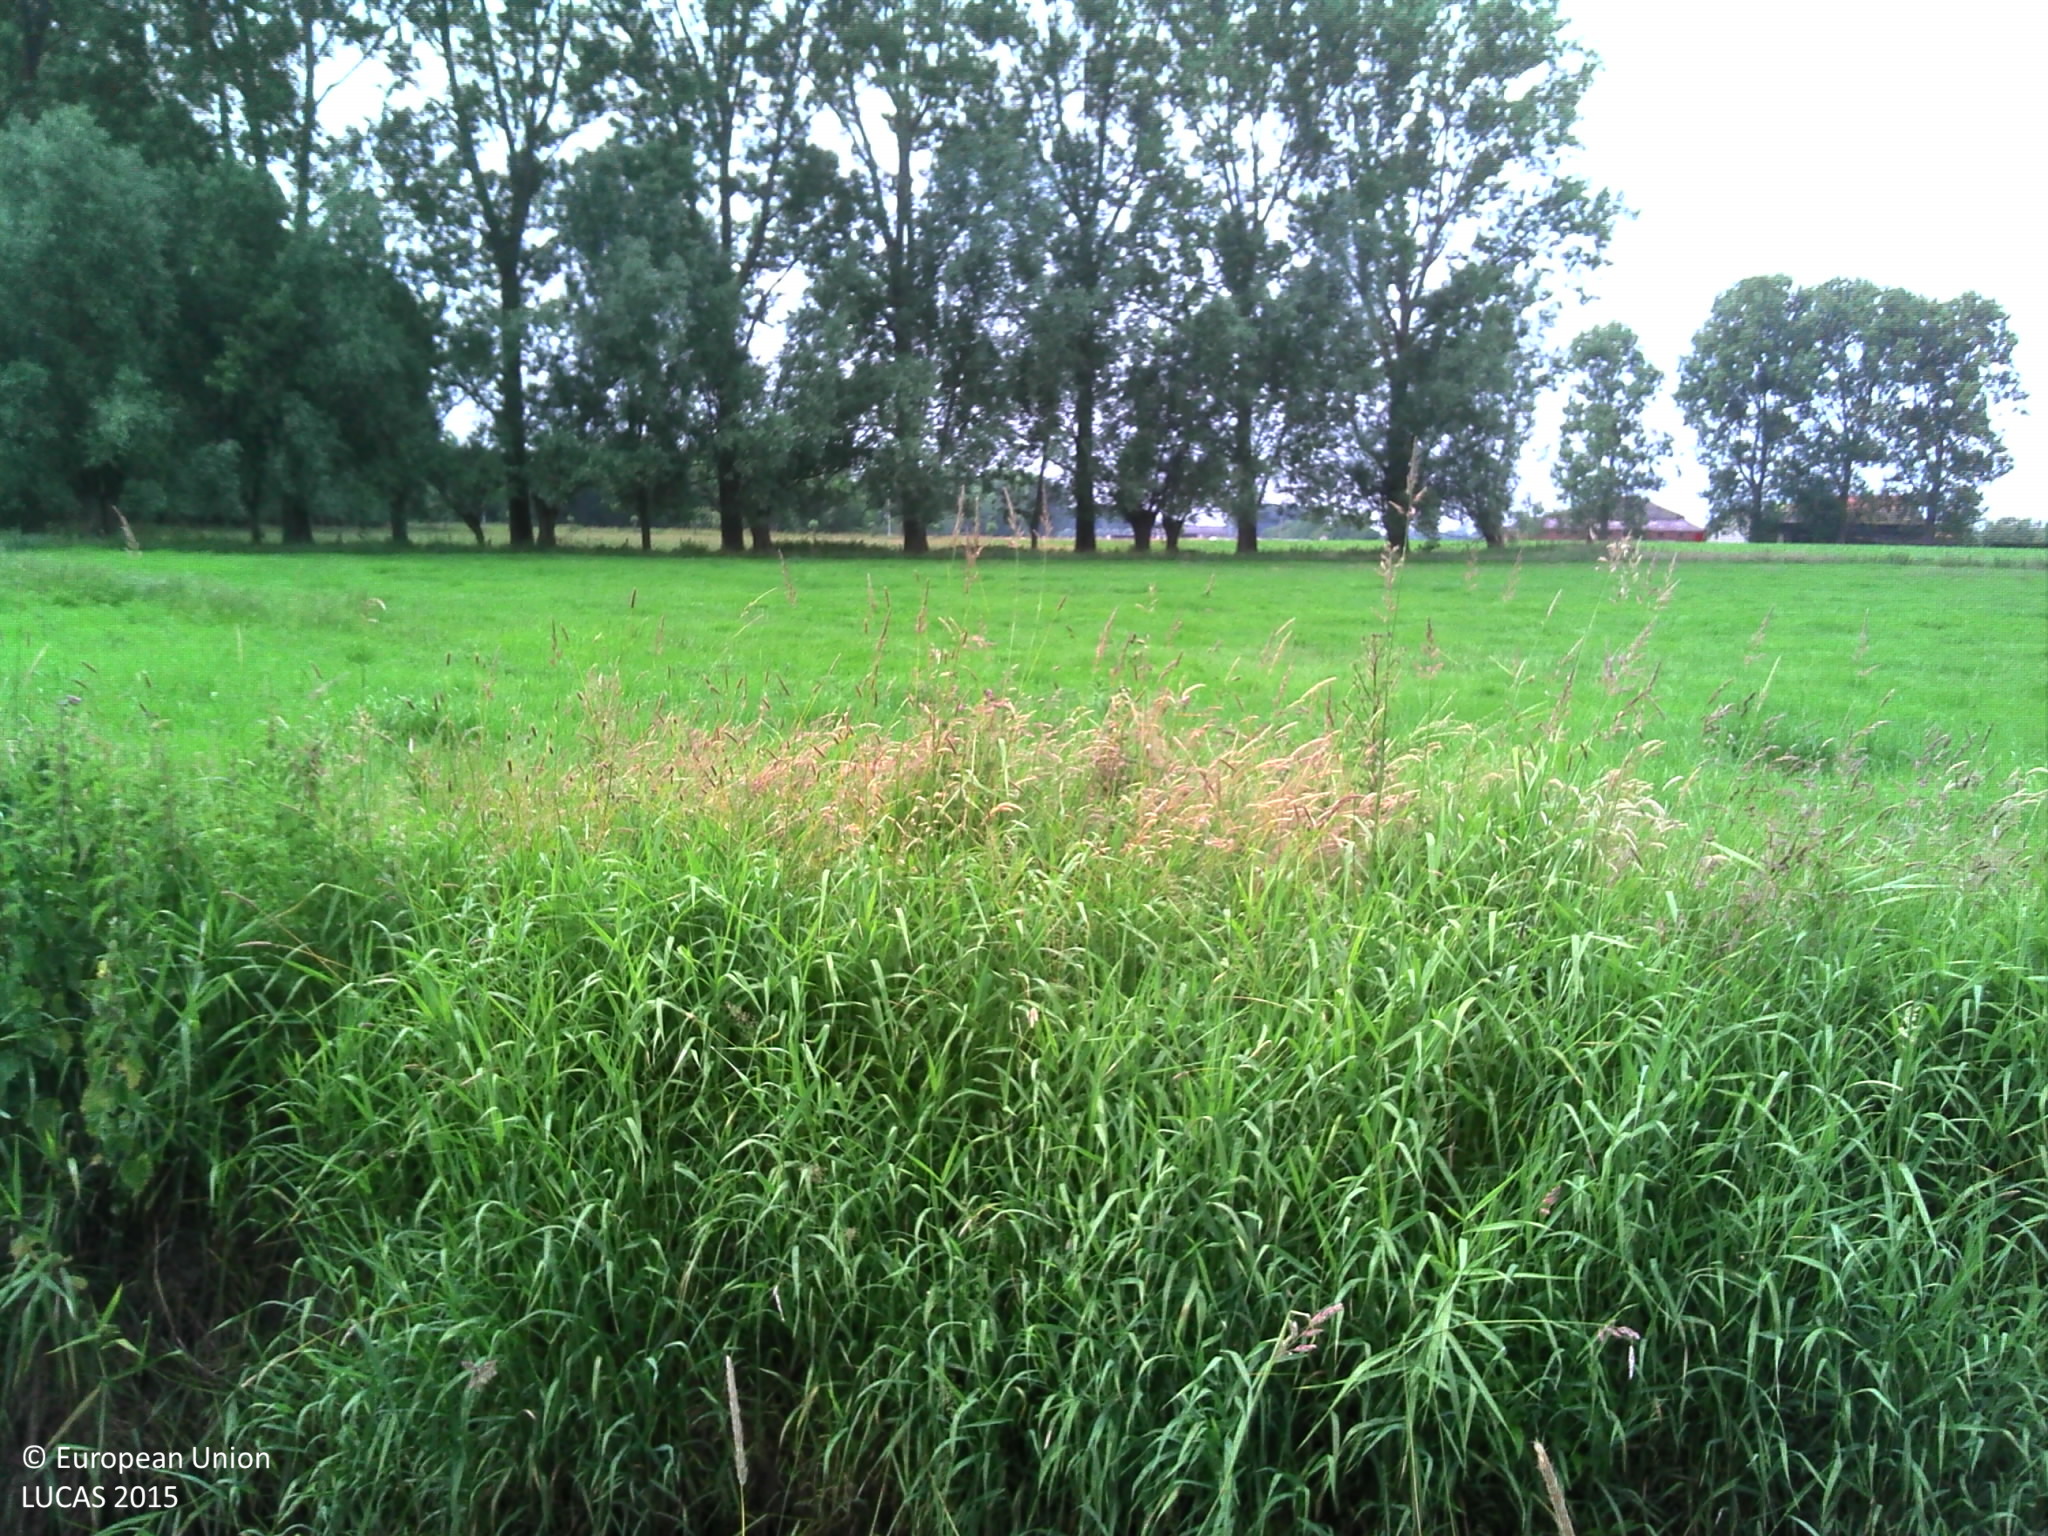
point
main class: Grassland
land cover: Grassland without tree/shrub cover
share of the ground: > 75 %
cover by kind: herbaceous plants 100 %
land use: Agriculture (excluding fallow land and kitchen gardens)
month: June
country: BE
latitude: 50.9704
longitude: 3.4556
